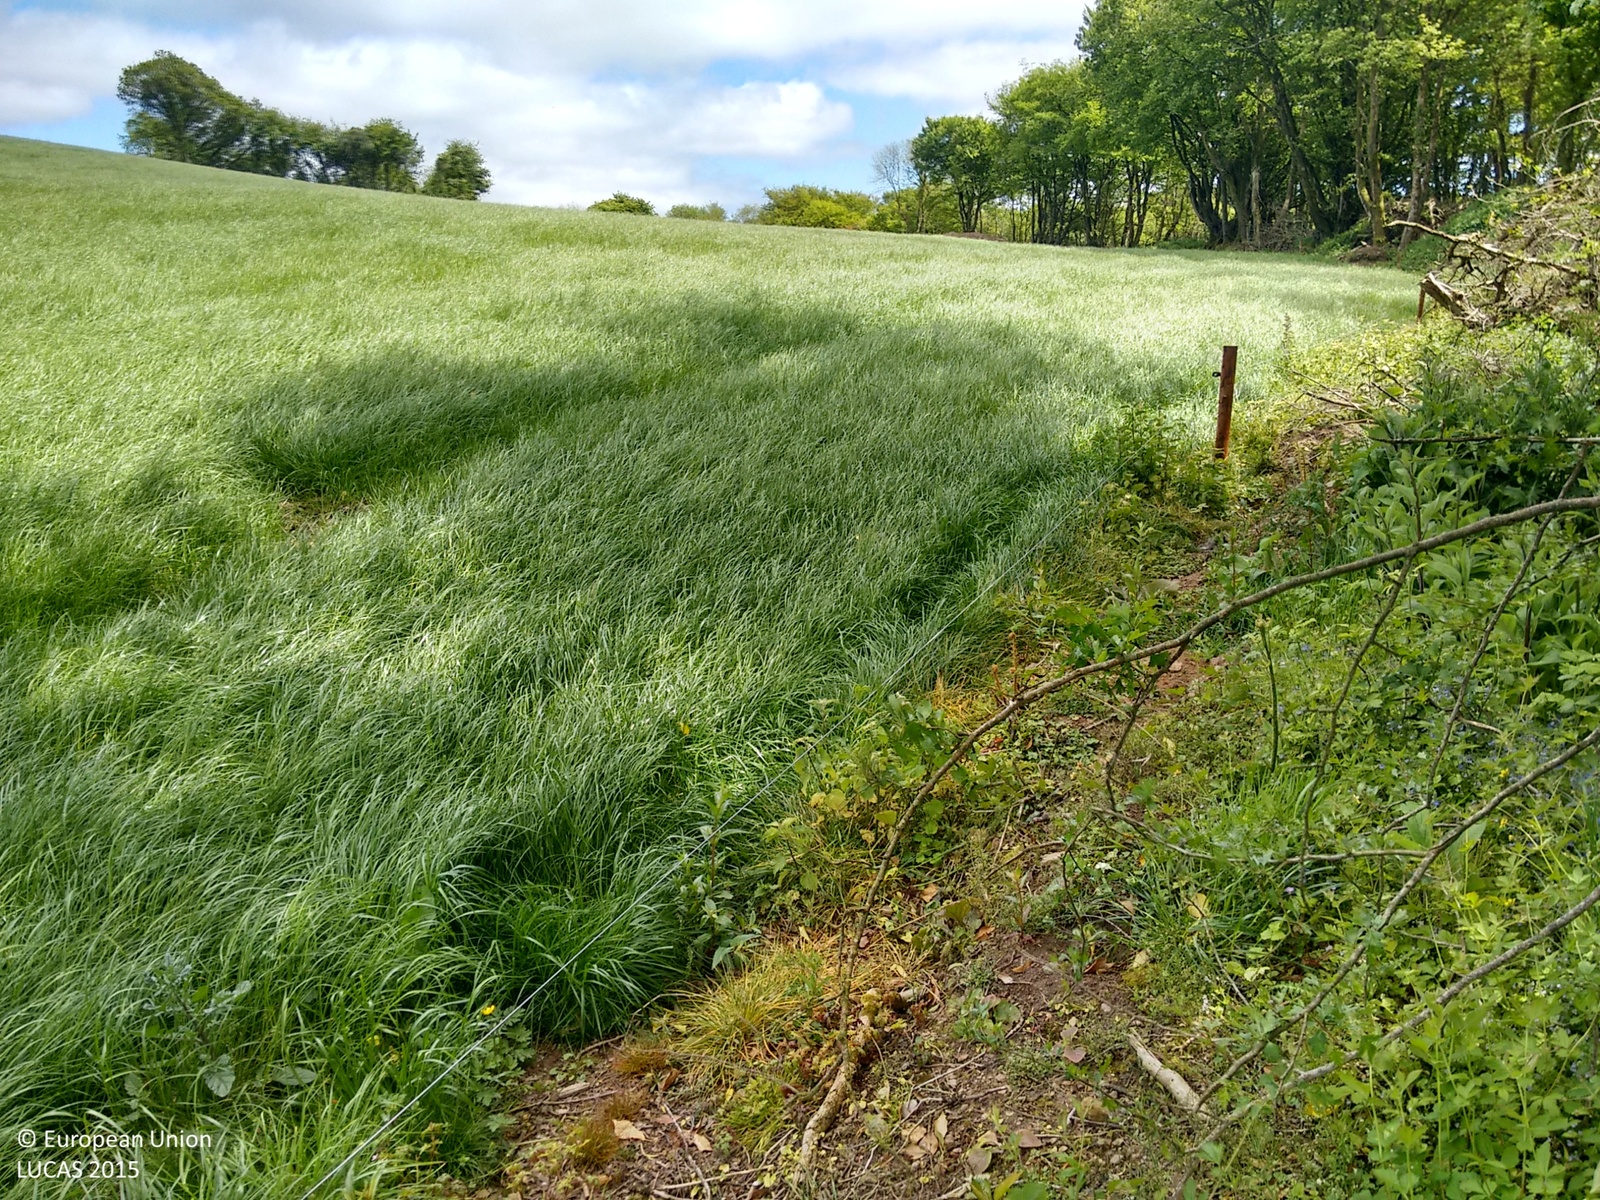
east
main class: Woodland
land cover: Broadleaved woodland
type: mesophytic deciduous forest
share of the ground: > 75 %
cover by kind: broadleaved forest trees 50 %, herbaceous plants 50 %
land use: Semi-natural and natural areas not in use
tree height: > 5 m
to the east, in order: Broadleaved woodland; Fences; Grassland without tree/shrub cover; Artificial constructions in urban areas; Broadleaved woodland; Rivers and streams; Broadleaved woodland
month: May
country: IE
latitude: 51.8448
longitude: -8.7393
